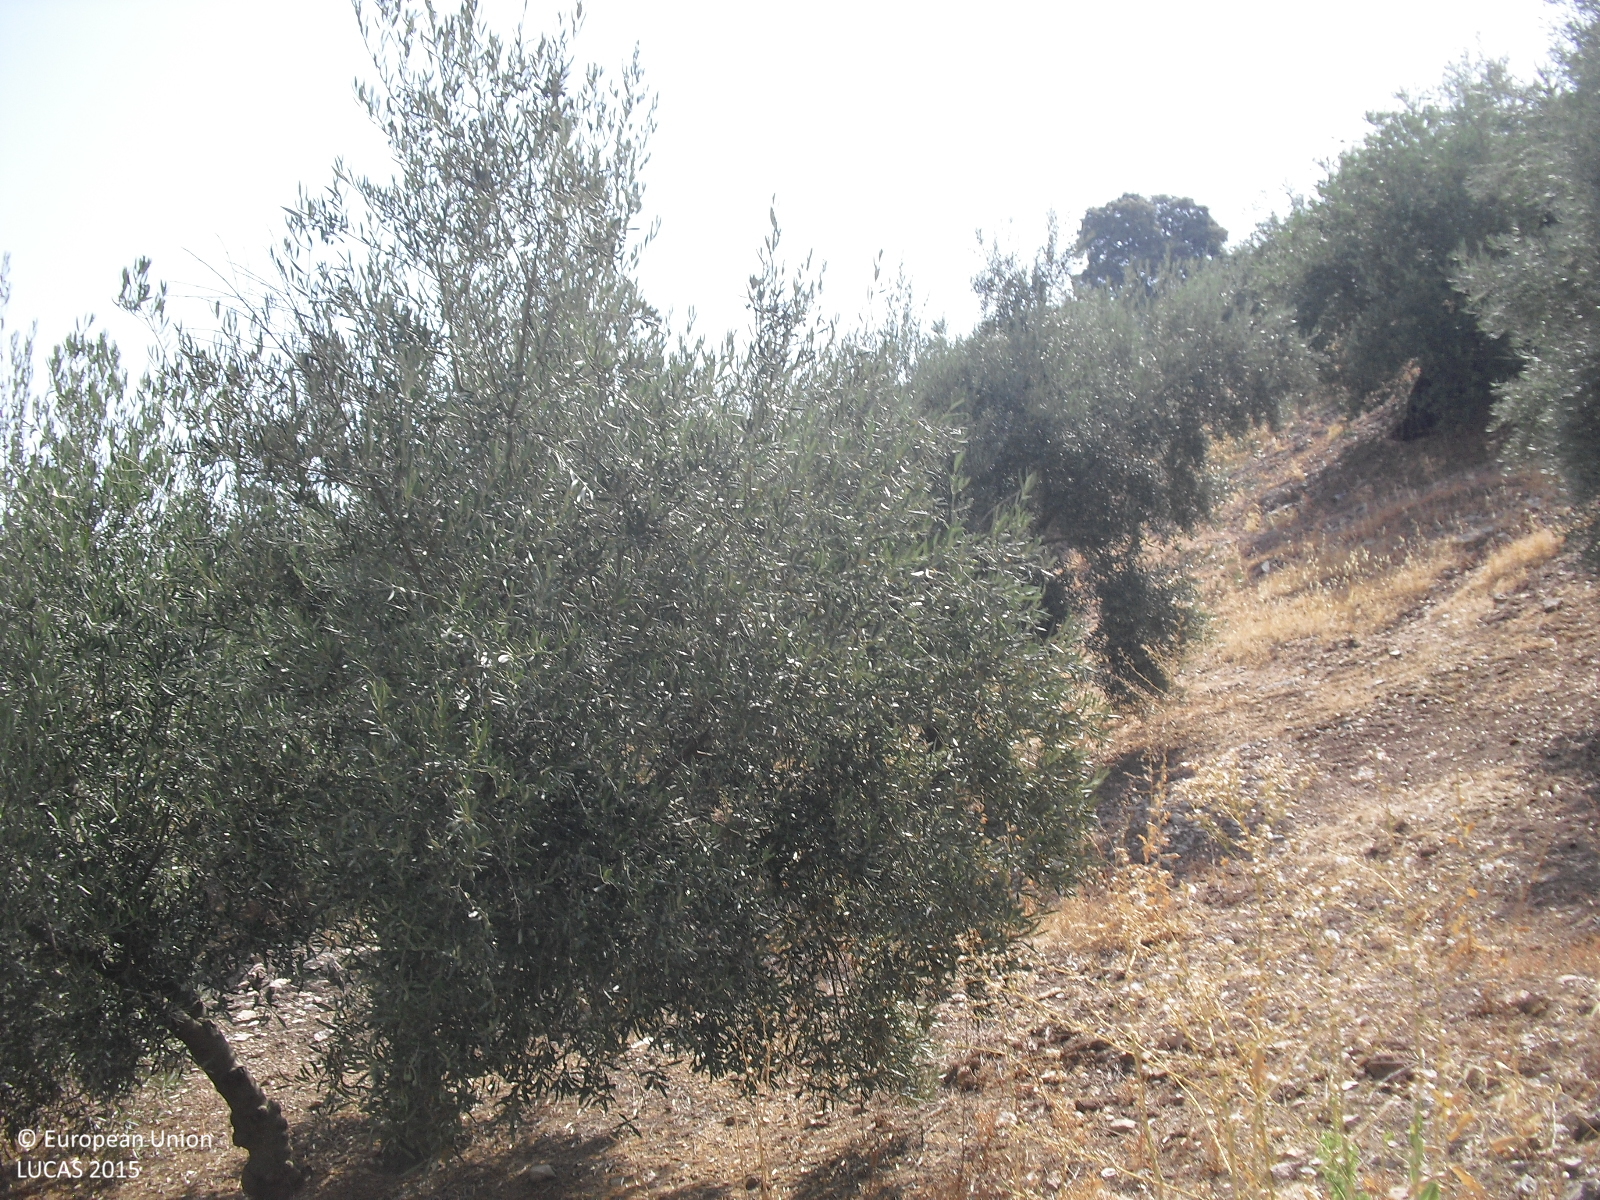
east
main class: Cropland
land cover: Olive groves
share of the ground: 25 - 50 %
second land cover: Spontaneously vegetated surfaces
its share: 10 - 25 %
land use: Agriculture (excluding fallow land and kitchen gardens)
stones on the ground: 10 - 25 %
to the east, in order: Olive groves; Spontaneously vegetated surfaces; Tracks; Olive groves
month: August
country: ES
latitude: 37.3220
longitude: -4.1826
